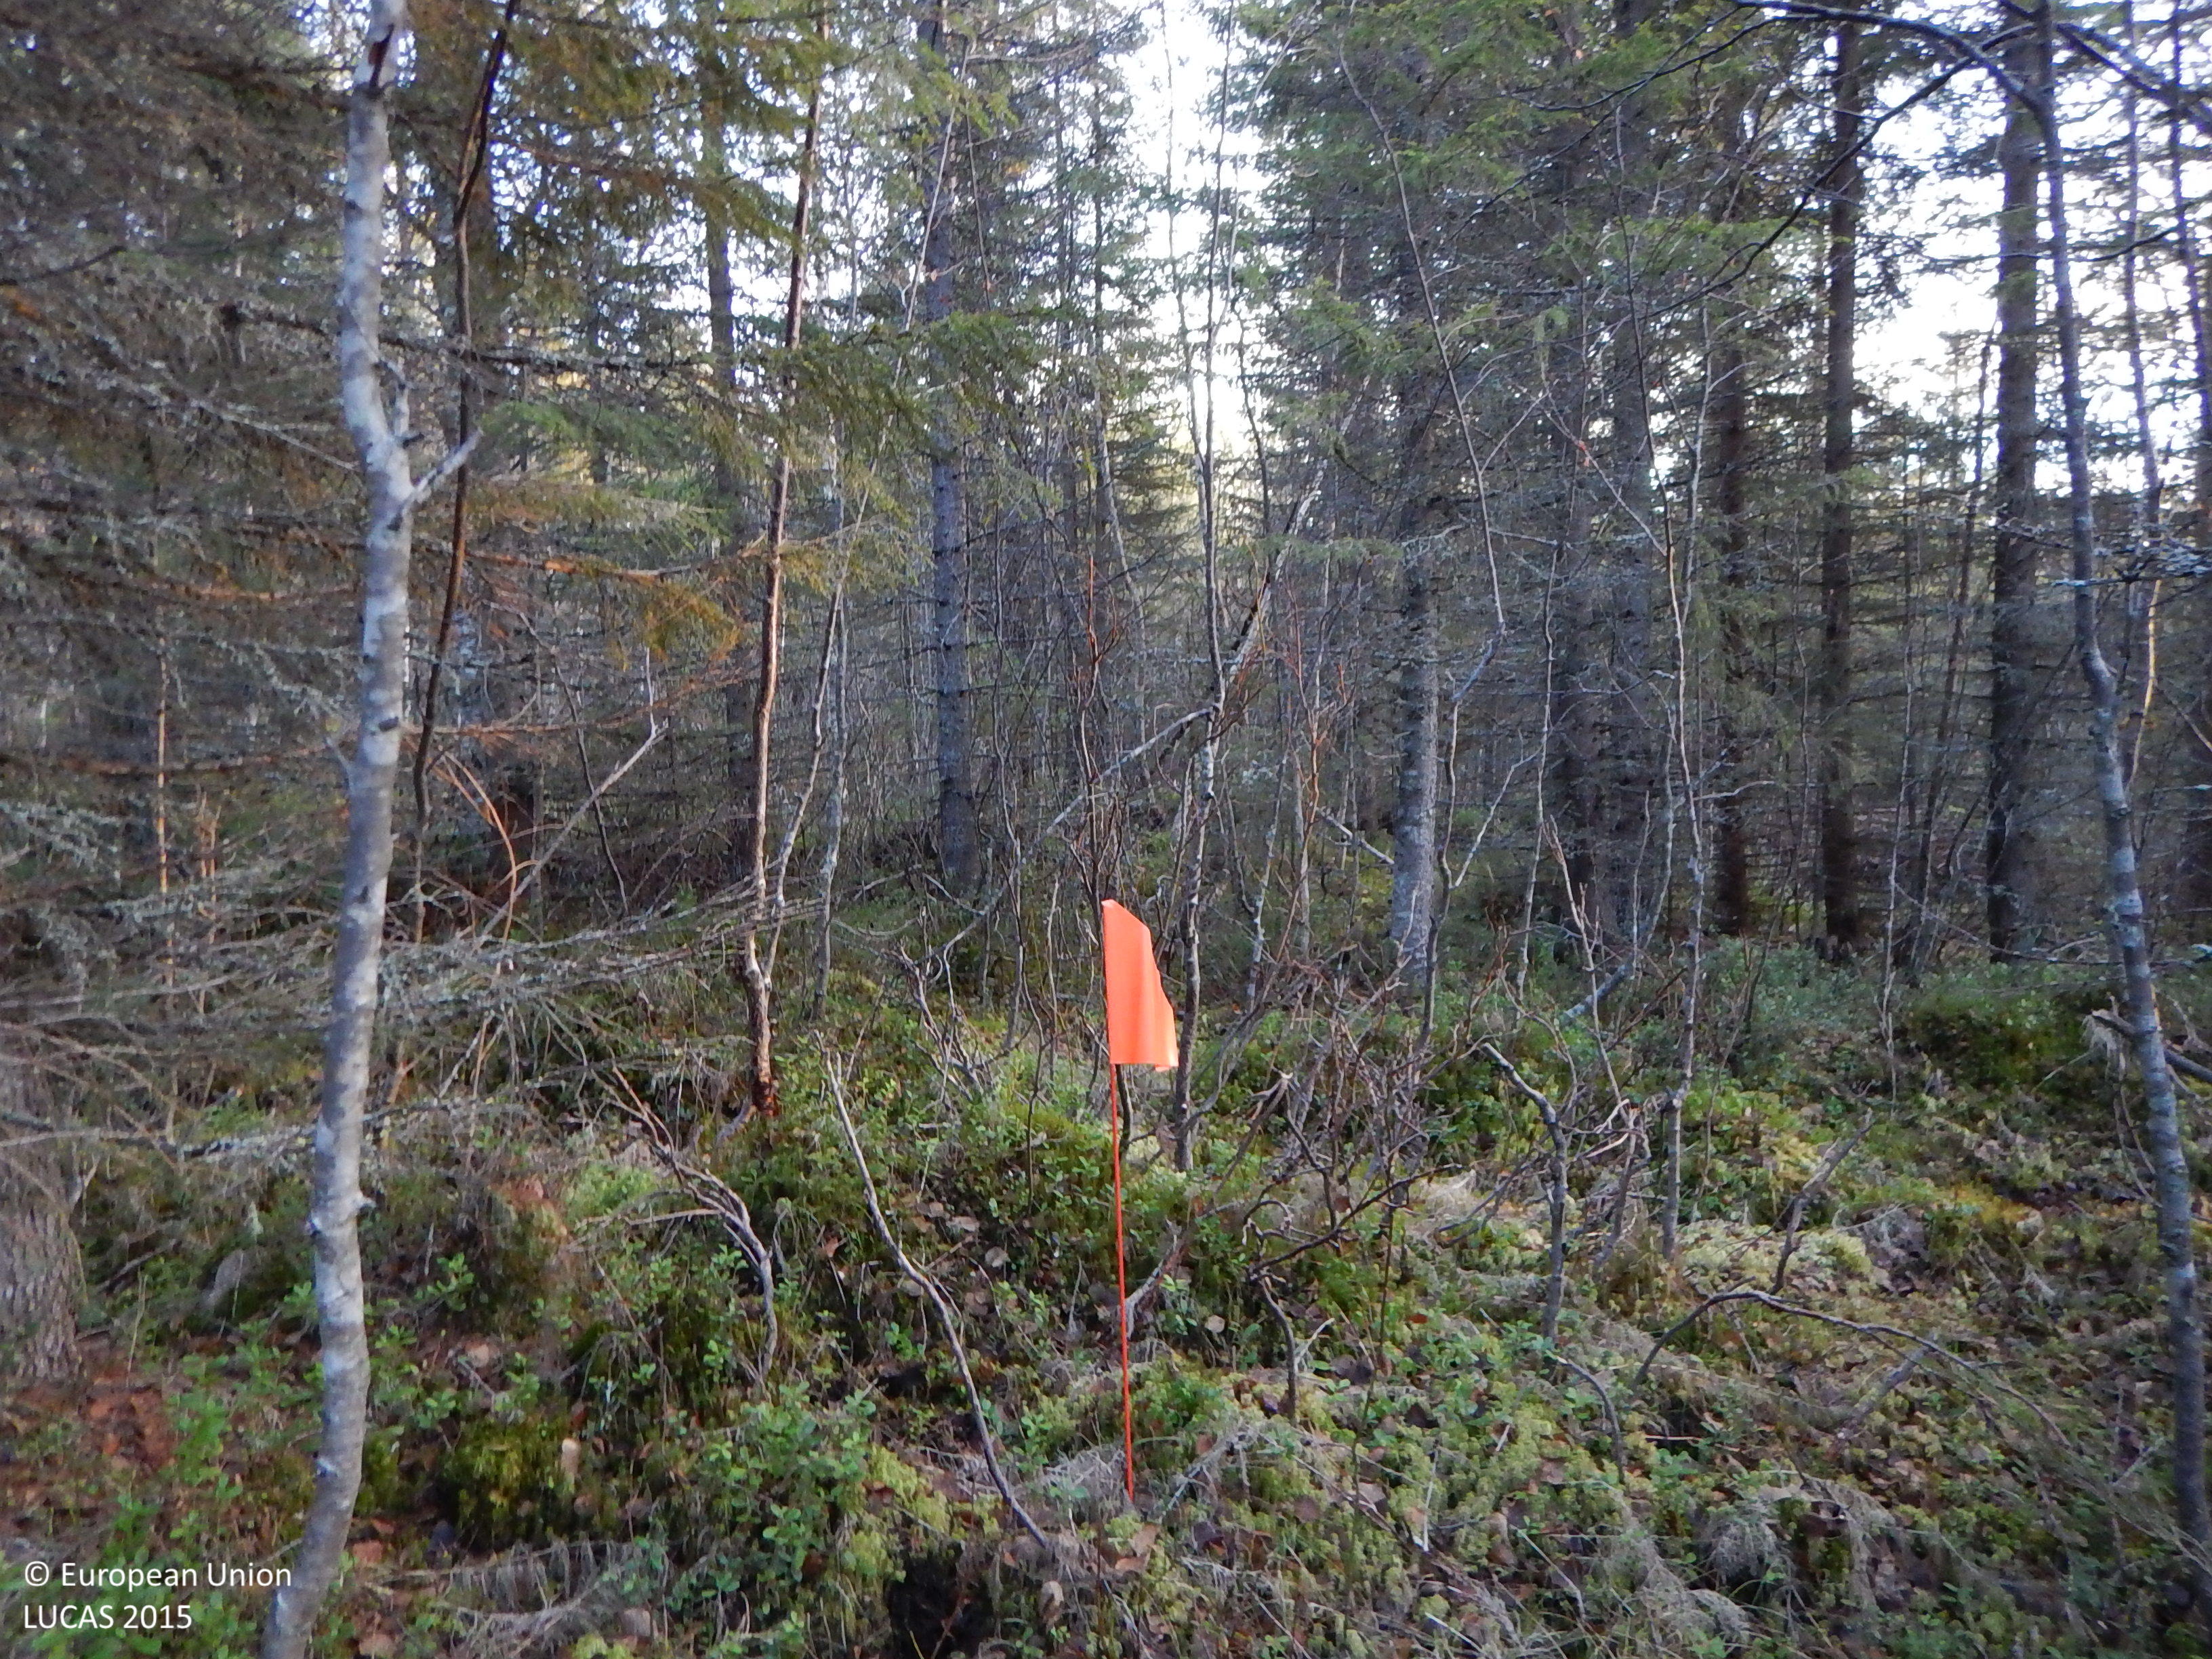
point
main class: Woodland
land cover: Spruce dominated mixed woodland
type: boreal forest
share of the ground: 50 - 75 %
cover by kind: coniferous forest trees 40 %, broadleaved forest trees 20 %, lichens and mosses 20 %, shrubs 10 %, herbaceous plants 10 %
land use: Forestry
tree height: > 5 m
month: November
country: SE
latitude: 65.2320
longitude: 20.5594
